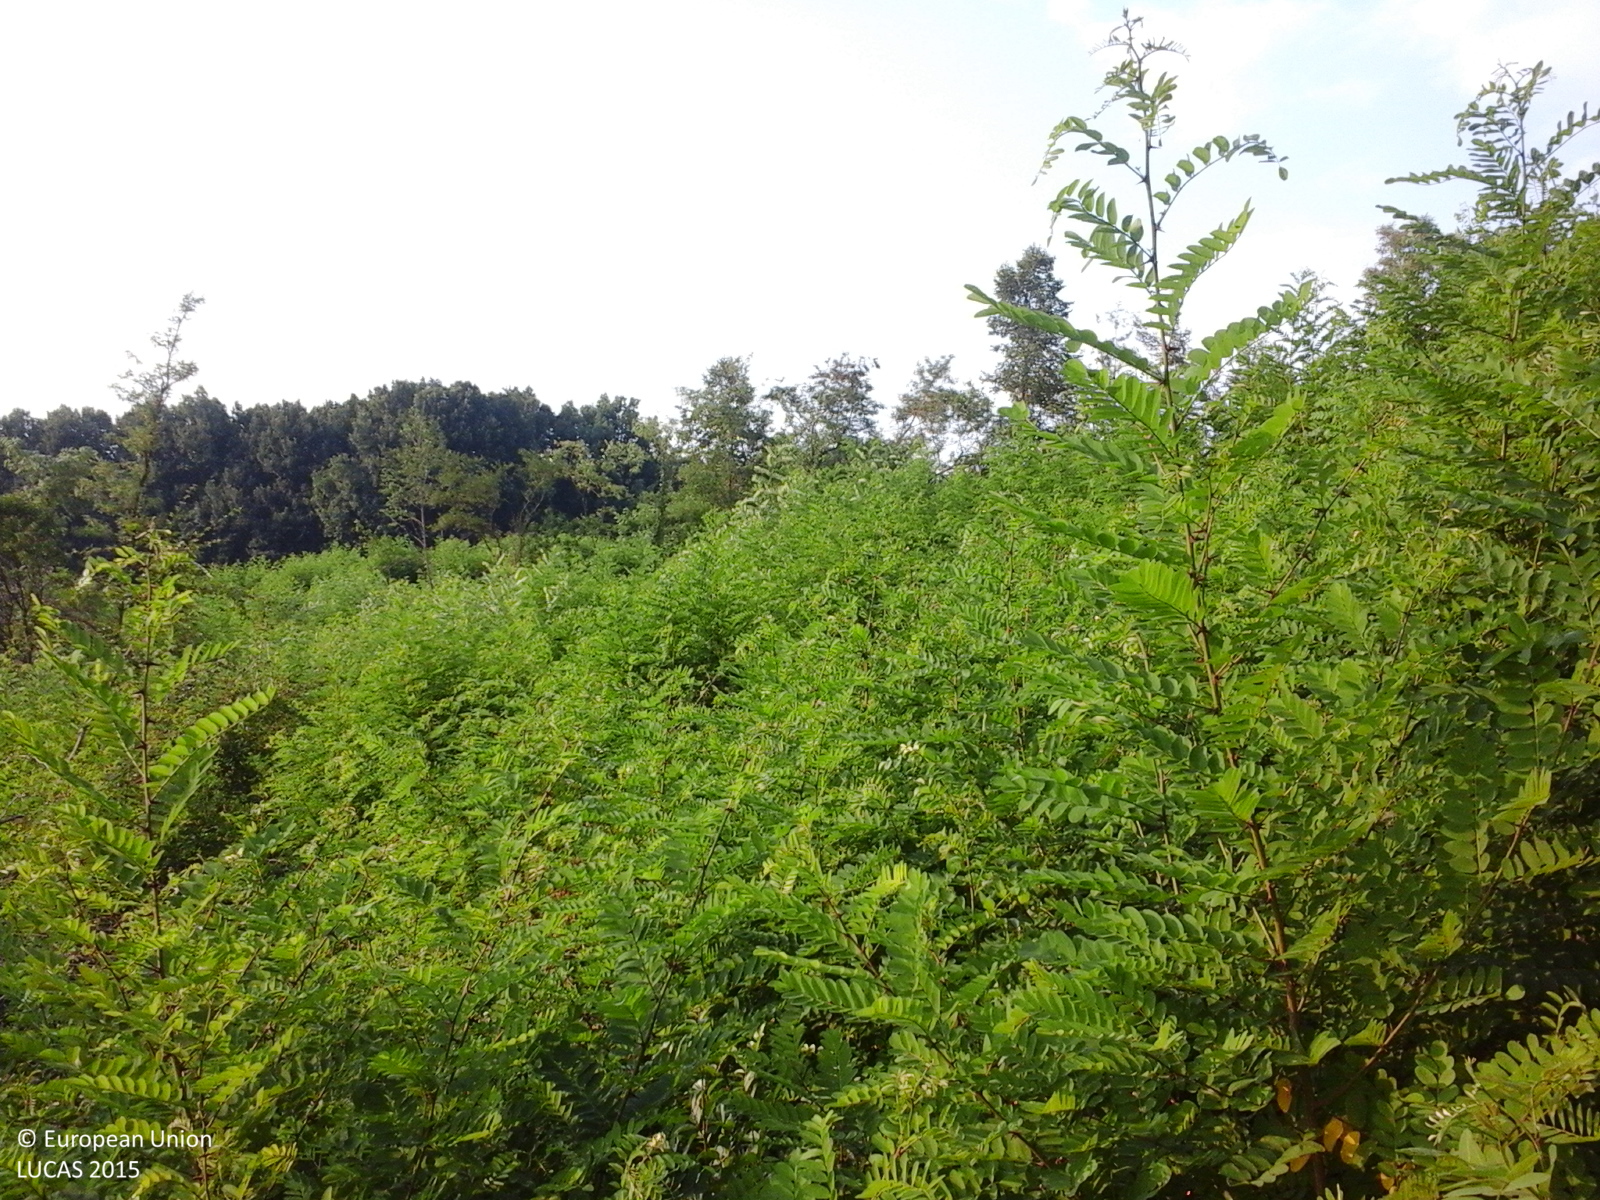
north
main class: Shrubland
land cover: Shrubland with sparse tree cover
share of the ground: > 75 %
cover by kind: shrubs 95 %, broadleaved forest trees 5 %
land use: Forestry
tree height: < 5 m
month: July
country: RO
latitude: 44.8644
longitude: 24.4893
